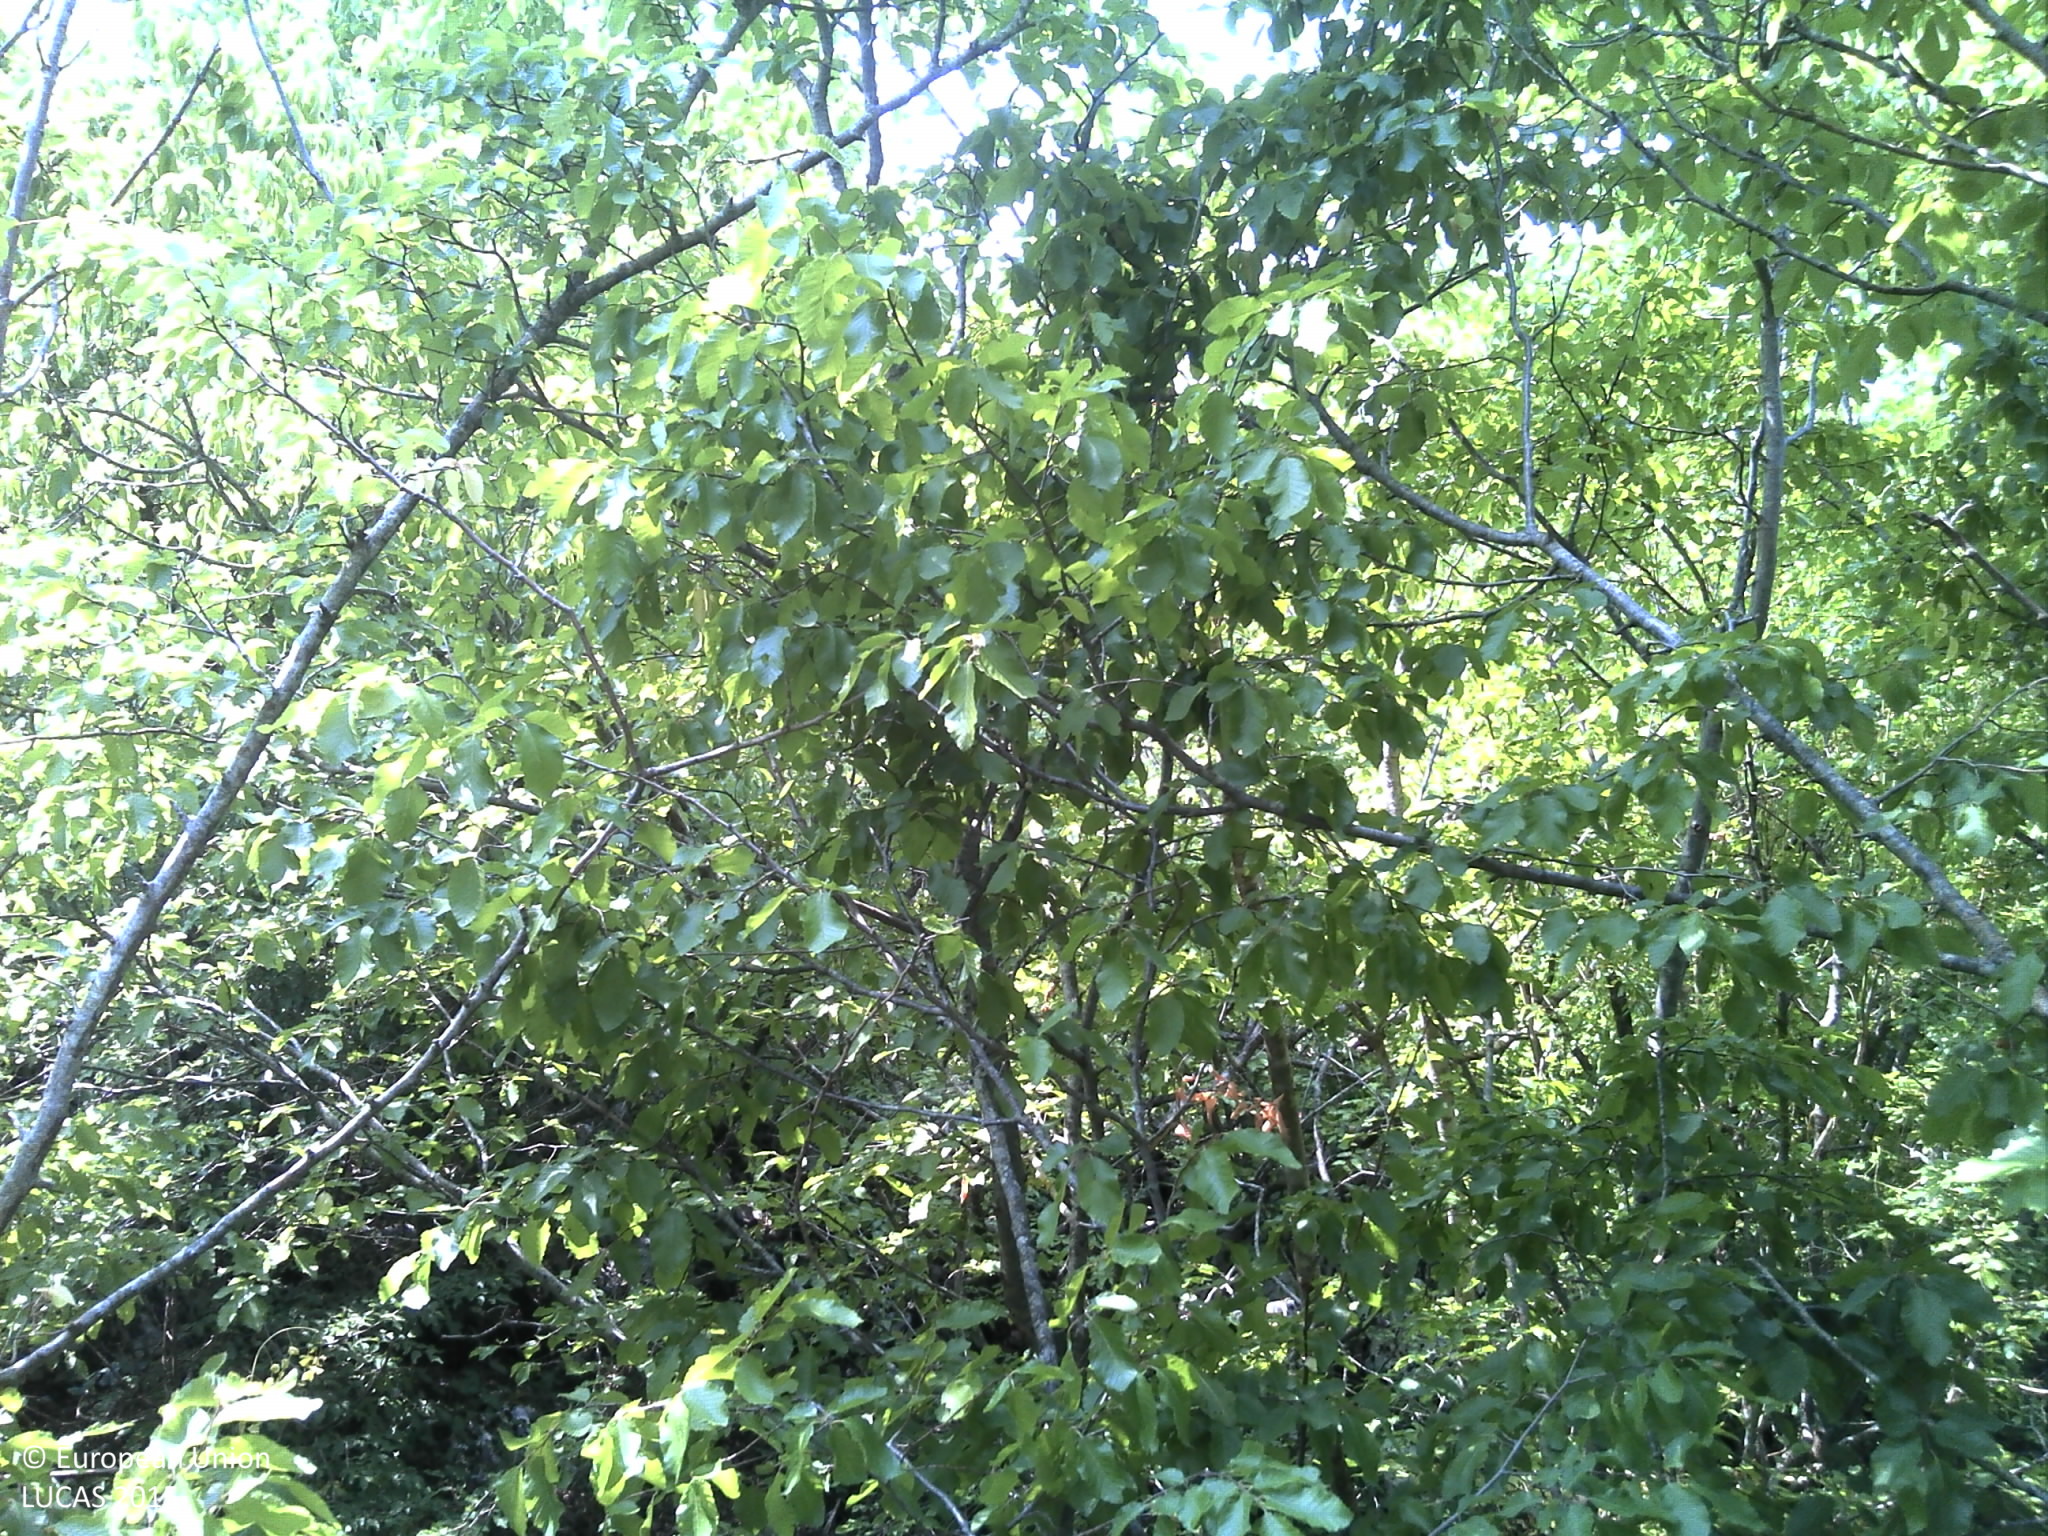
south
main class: Woodland
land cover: Broadleaved woodland
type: thermophilous deciduous forest
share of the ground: 50 - 75 %
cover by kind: broadleaved forest trees 65 %, shrubs 25 %, herbaceous plants 5 %, consolidated bare surface 5 %
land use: Semi-natural and natural areas not in use
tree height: > 5 m
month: July
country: HR
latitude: 43.5033
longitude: 16.9301
